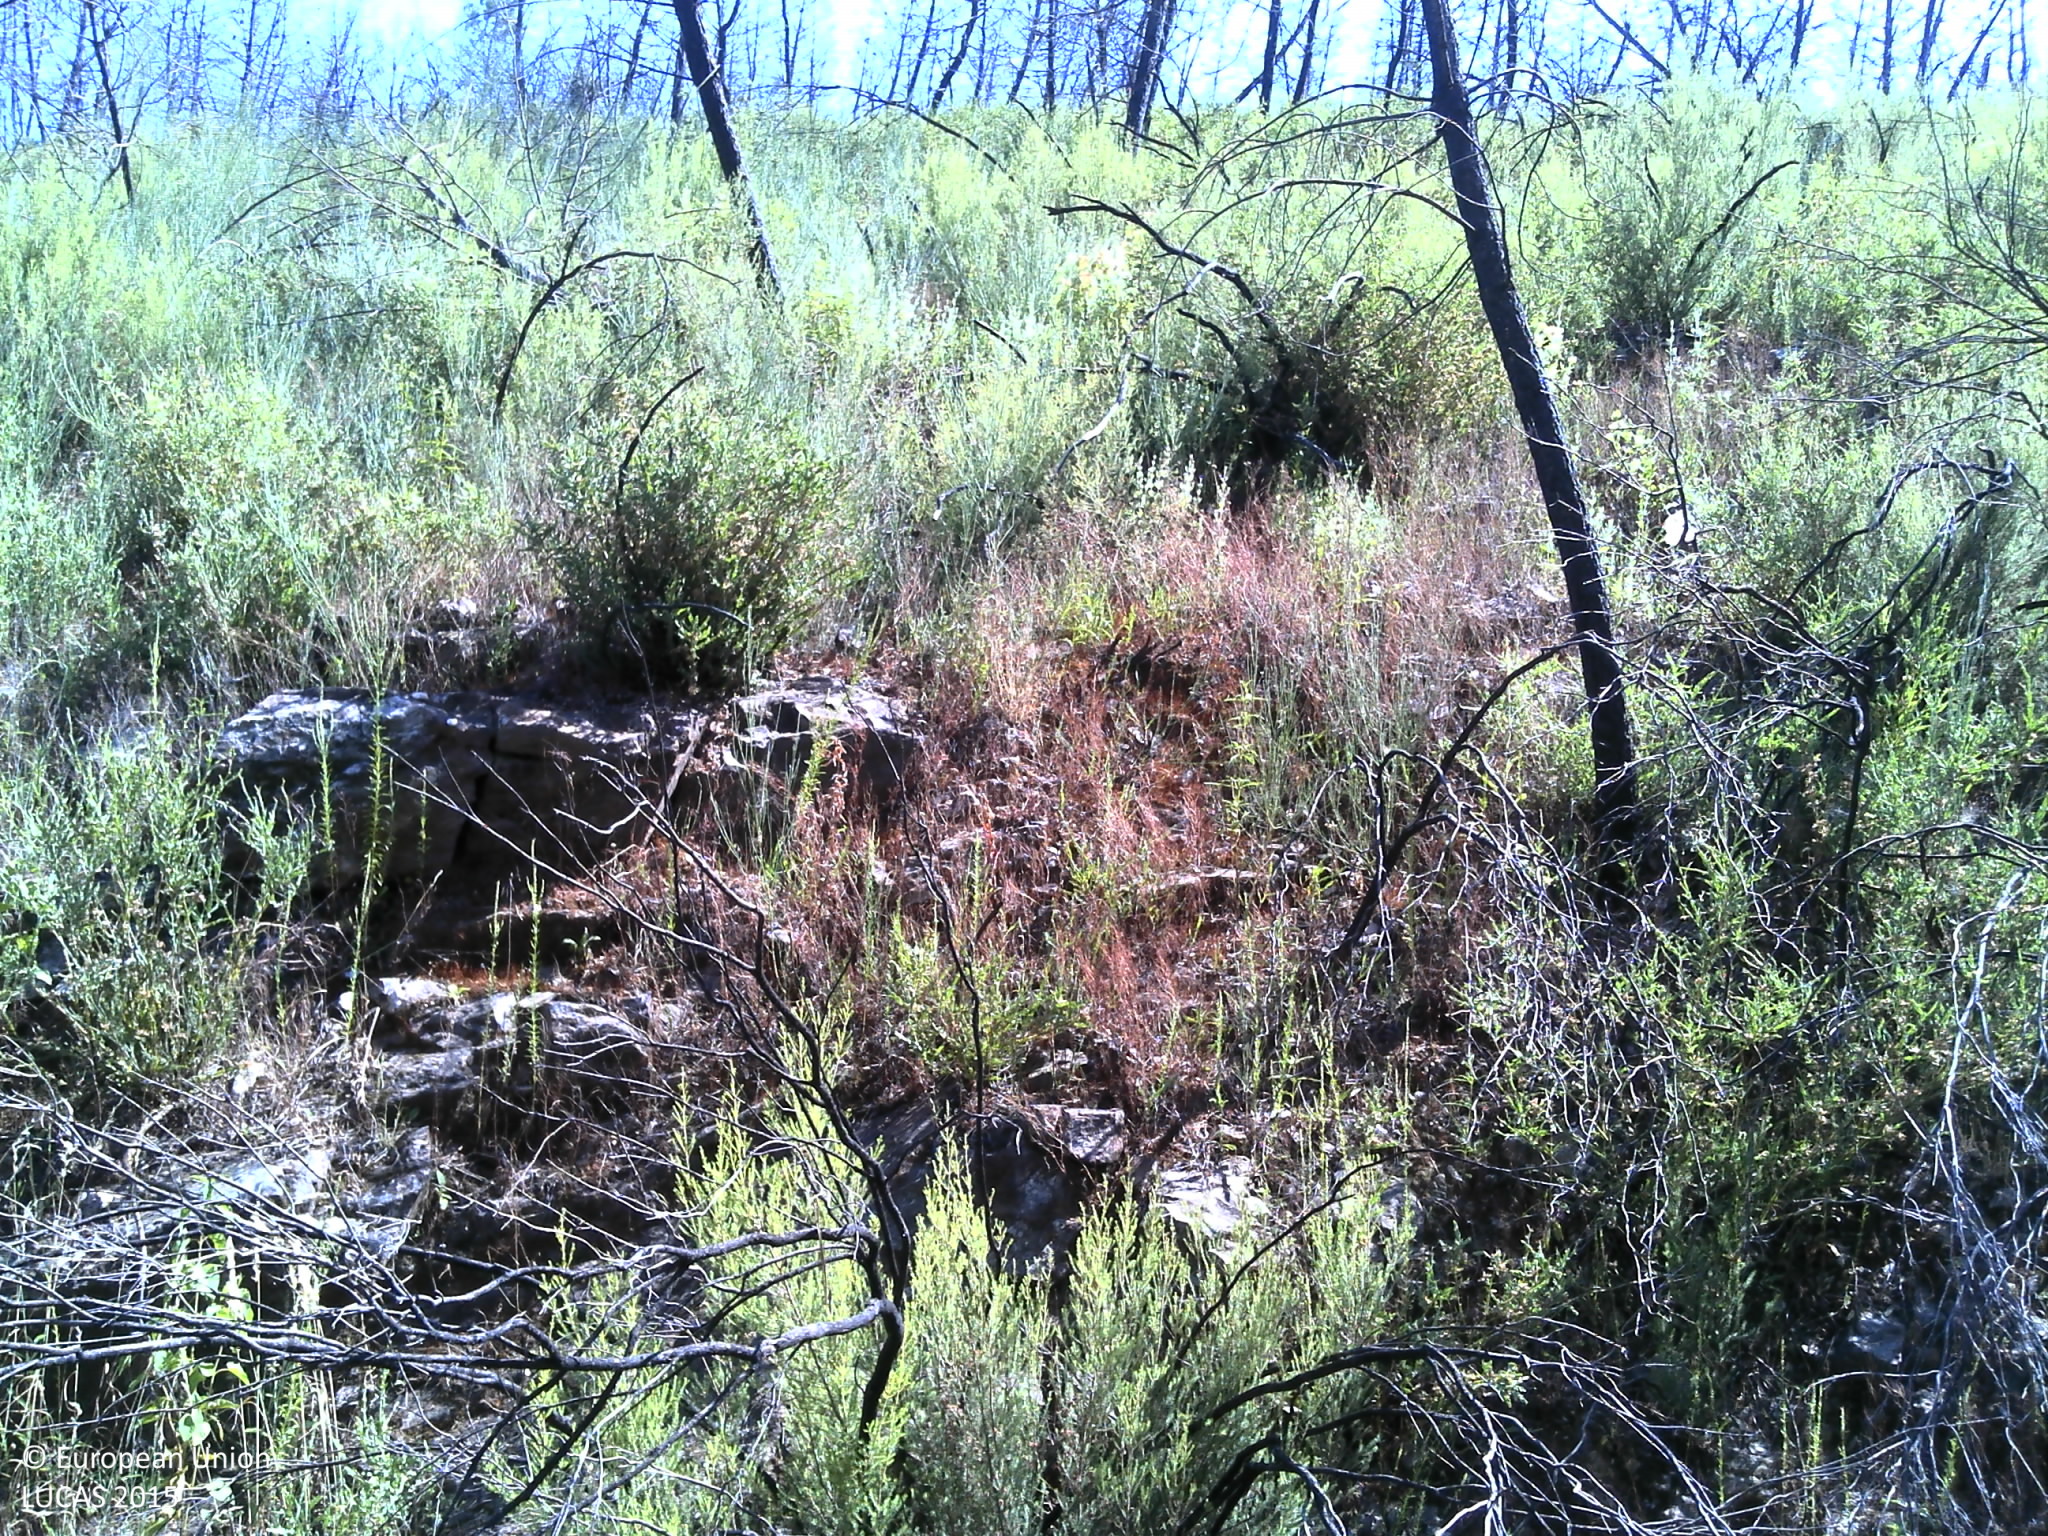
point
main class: Woodland
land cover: Pine dominated coniferous woodland
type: coniferous forest of the mediterranean region
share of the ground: < 10 %
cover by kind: shrubs 80 %, coniferous forest trees 10 %, herbaceous plants 5 %, unconsolidated bare surface 5 %
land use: Abandoned areas
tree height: > 5 m
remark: Burnt area
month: June
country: PT
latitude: 41.2001
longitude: -6.8119
